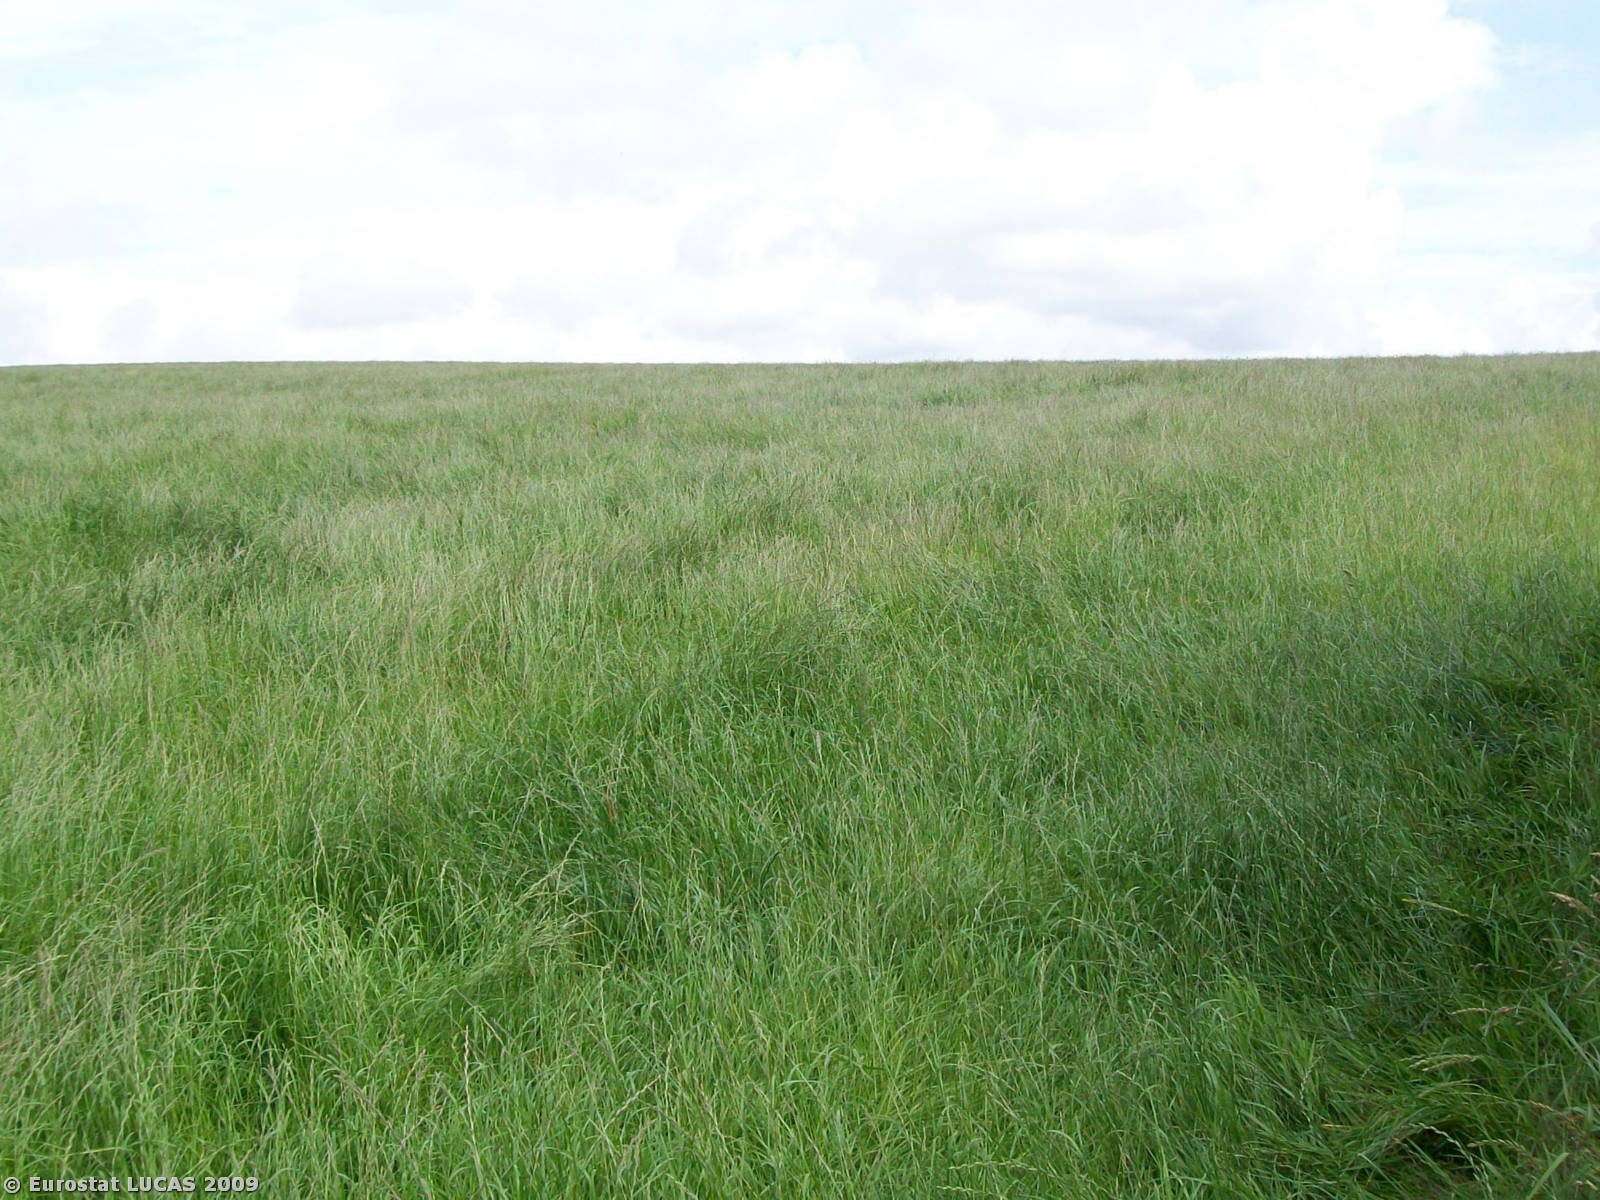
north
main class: Grassland
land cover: Grassland without tree/shrub cover
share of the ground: > 75 %
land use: Agriculture (excluding fallow land and kitchen gardens)
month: July
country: GB
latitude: 55.0705
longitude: -3.3099
